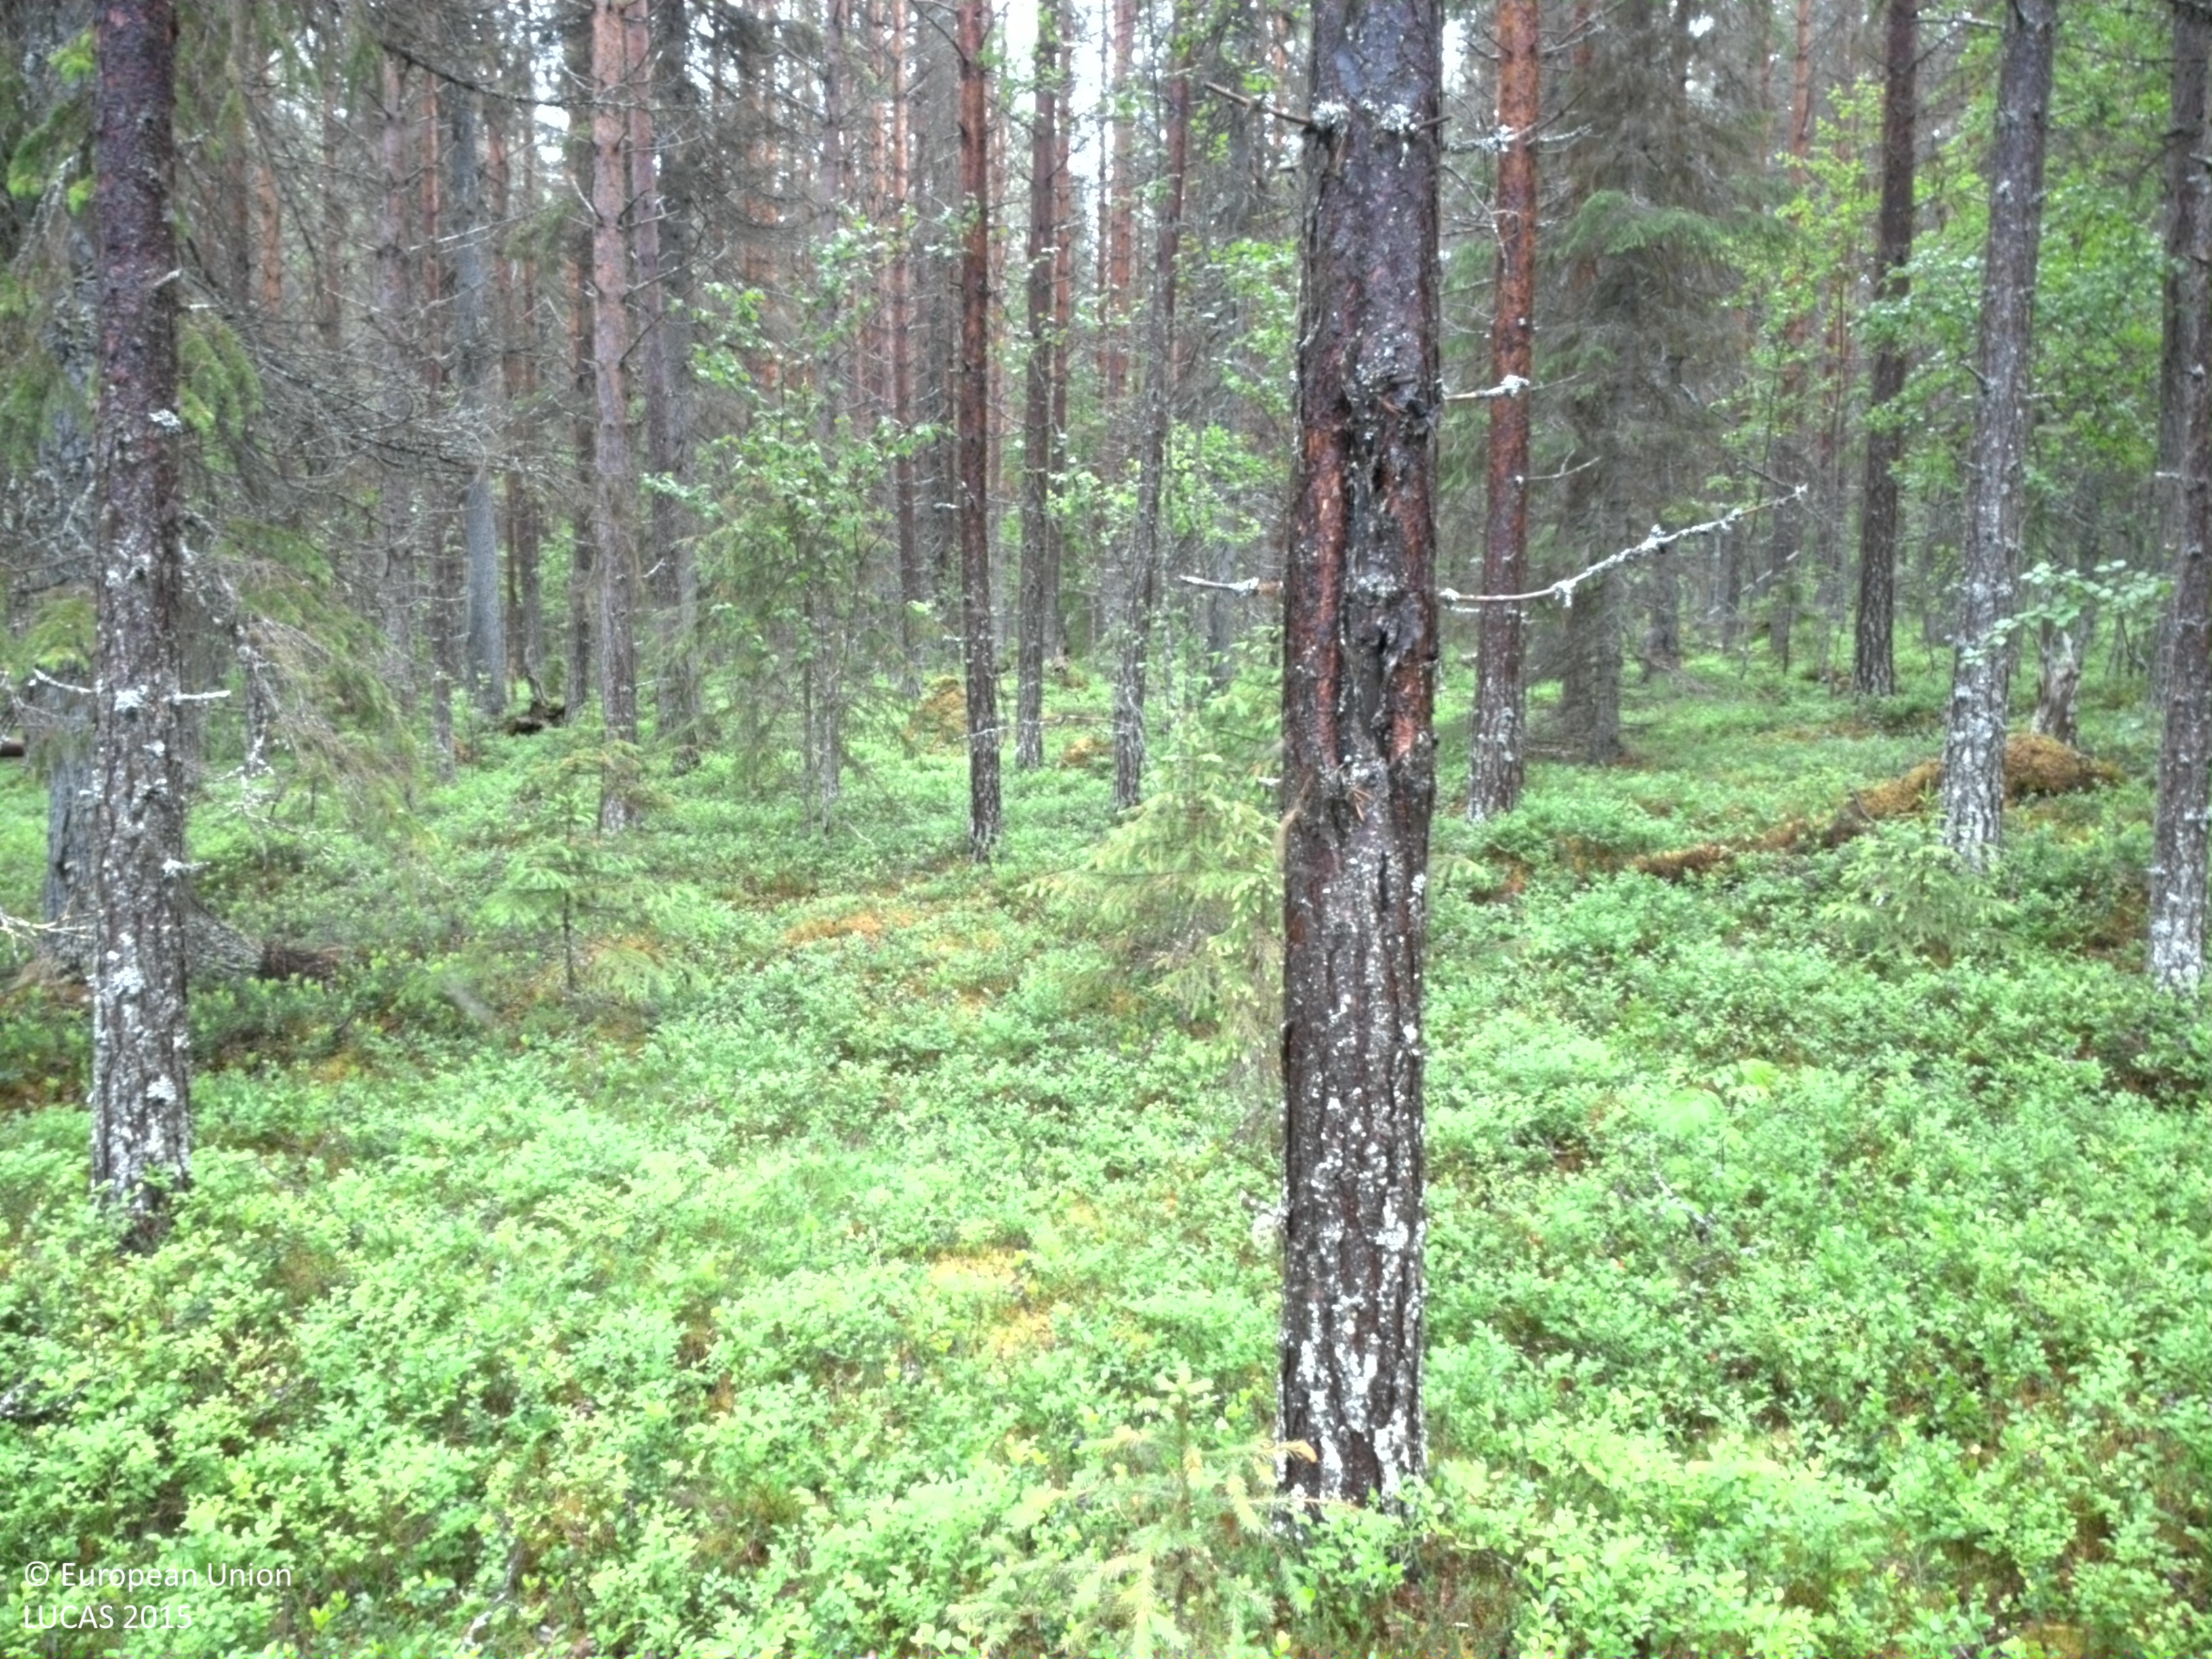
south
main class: Woodland
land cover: Pine dominated coniferous woodland
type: boreal forest
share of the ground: 50 - 75 %
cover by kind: coniferous forest trees 65 %, shrubs 20 %, broadleaved forest trees 10 %, lichens and mosses 5 %
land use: Forestry
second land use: Amenities, museums, leisure
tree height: > 5 m
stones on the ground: 25 - 50 %
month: July
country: SE
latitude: 64.6365
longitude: 18.2732
